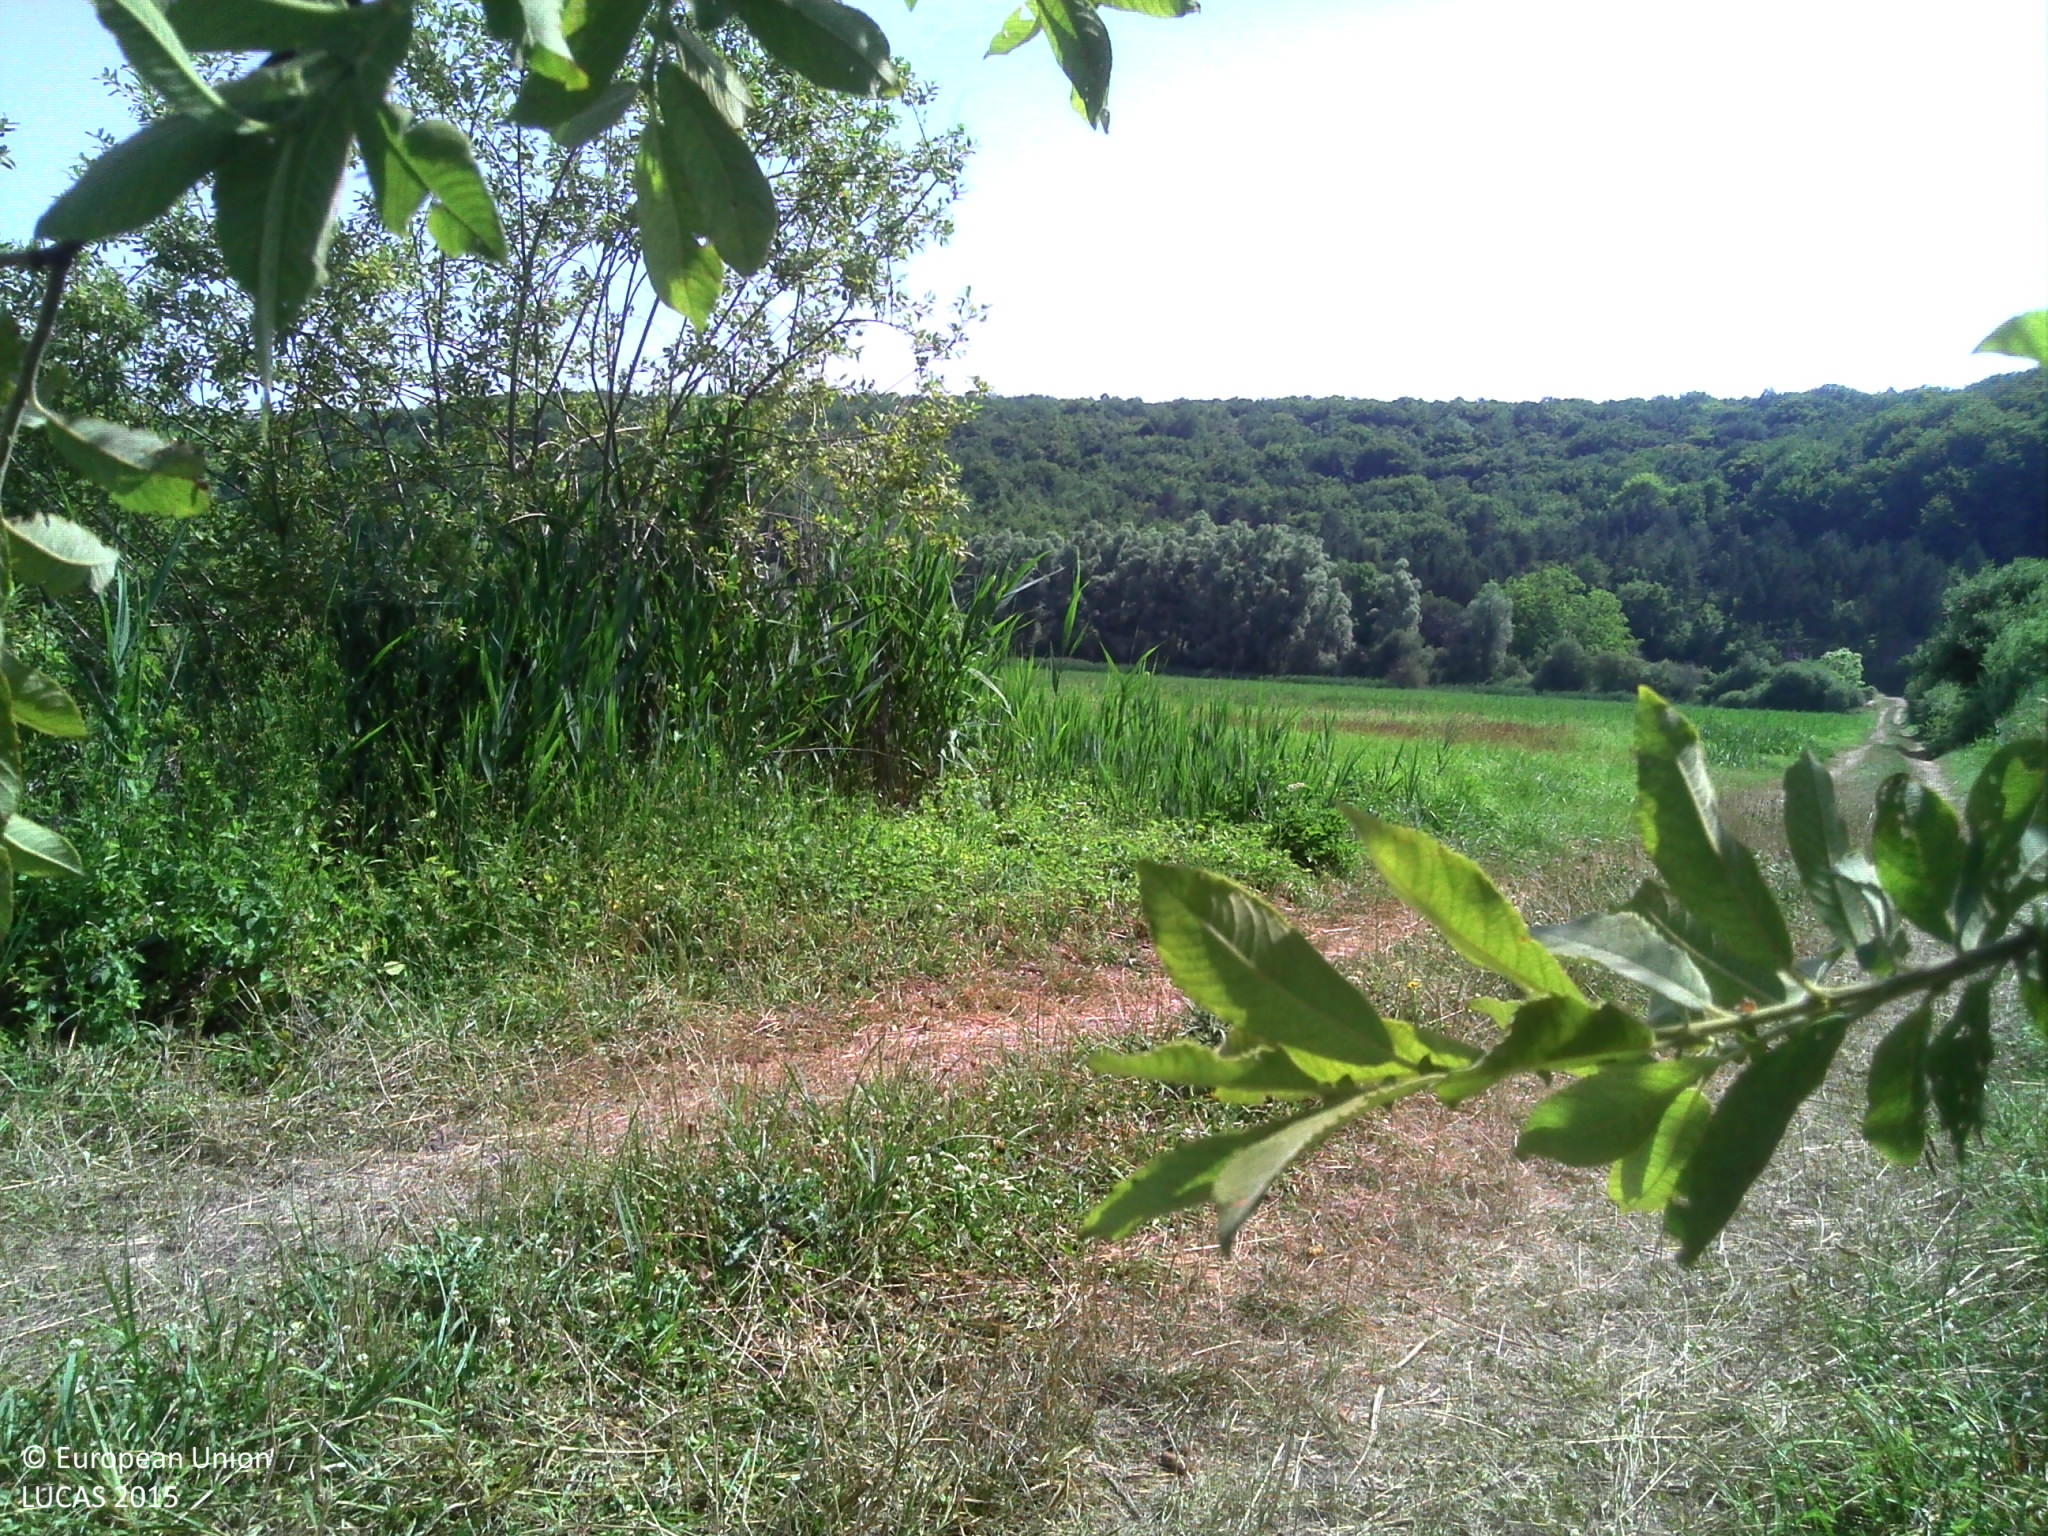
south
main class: Grassland
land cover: Grassland without tree/shrub cover
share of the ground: > 75 %
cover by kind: herbaceous plants 100 %
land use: Agriculture (excluding fallow land and kitchen gardens)
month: July
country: FR
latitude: 47.5247
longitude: 3.4749
